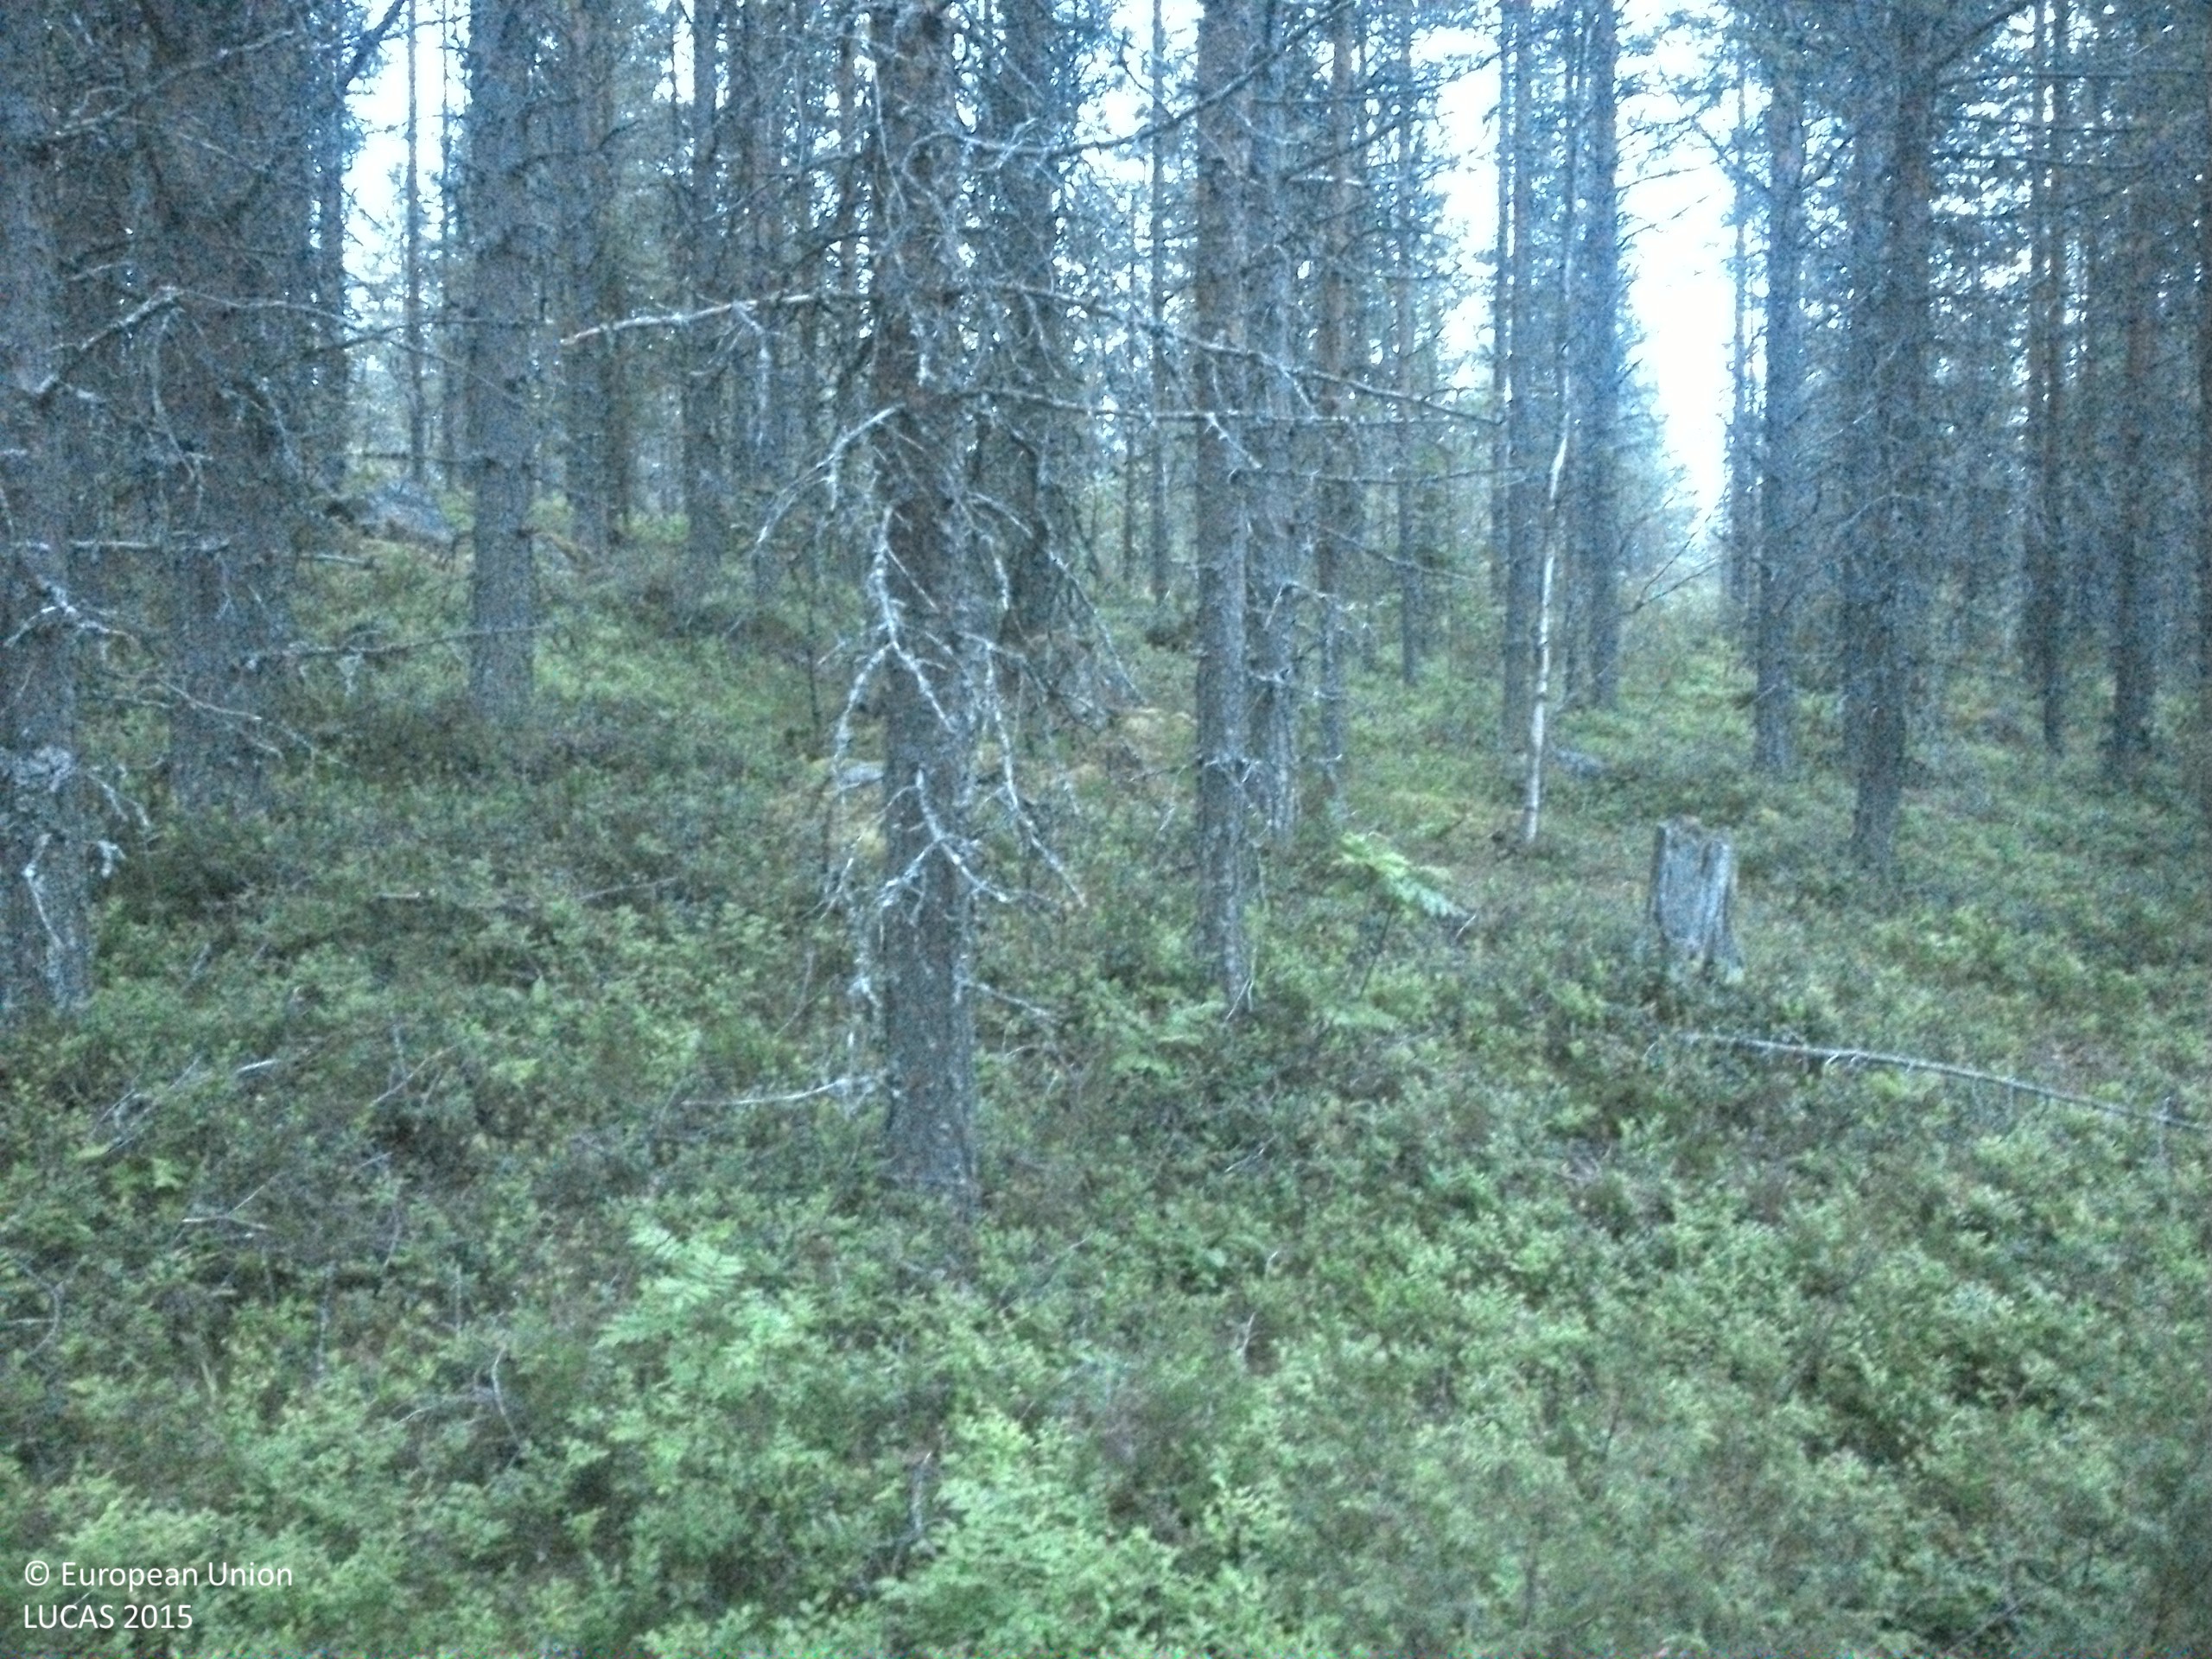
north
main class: Woodland
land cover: Pine dominated coniferous woodland
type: boreal forest
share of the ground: 50 - 75 %
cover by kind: coniferous forest trees 55 %, shrubs 35 %, broadleaved forest trees 5 %, herbaceous plants 5 %
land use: Forestry
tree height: > 5 m
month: July
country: SE
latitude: 64.2252
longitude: 16.5858
